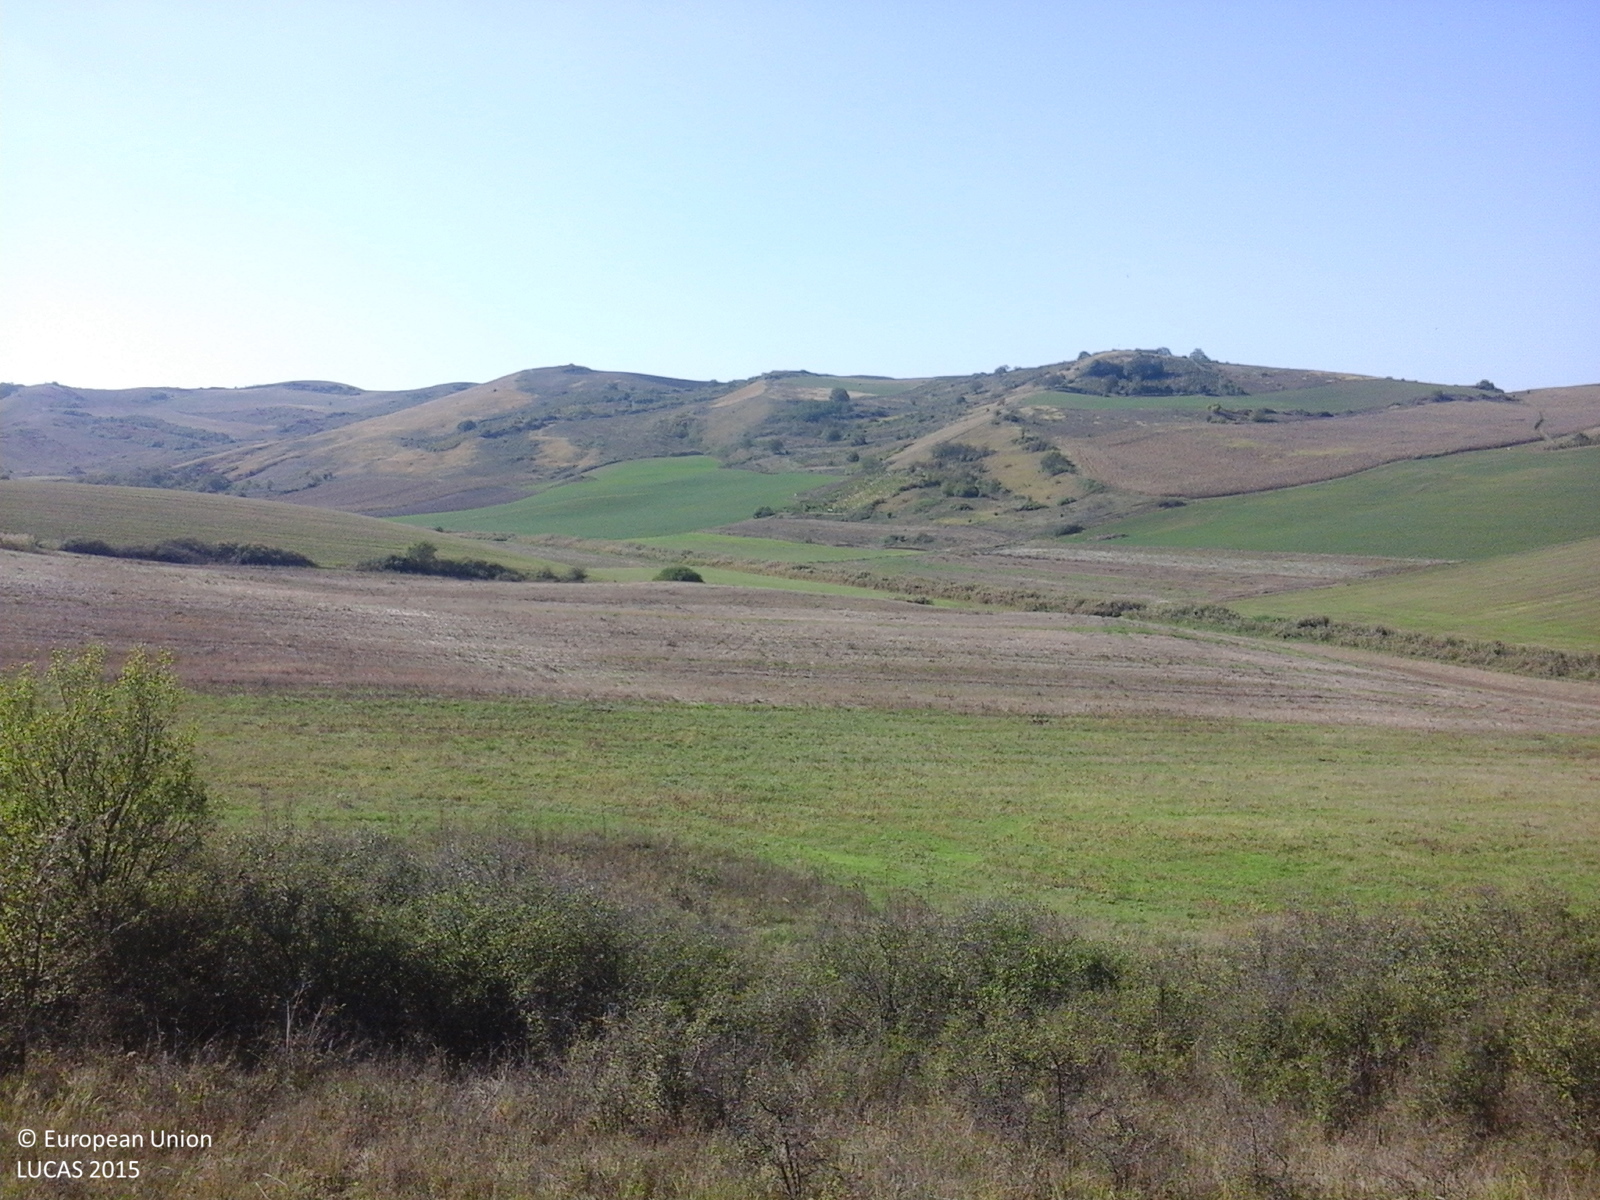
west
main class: Grassland
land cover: Grassland with sparse tree/shrub cover
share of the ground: > 75 %
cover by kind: herbaceous plants 85 %, shrubs 10 %, broadleaved forest trees 5 %
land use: Fallow land
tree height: < 5 m
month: October
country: RO
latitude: 46.2715
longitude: 23.8135
